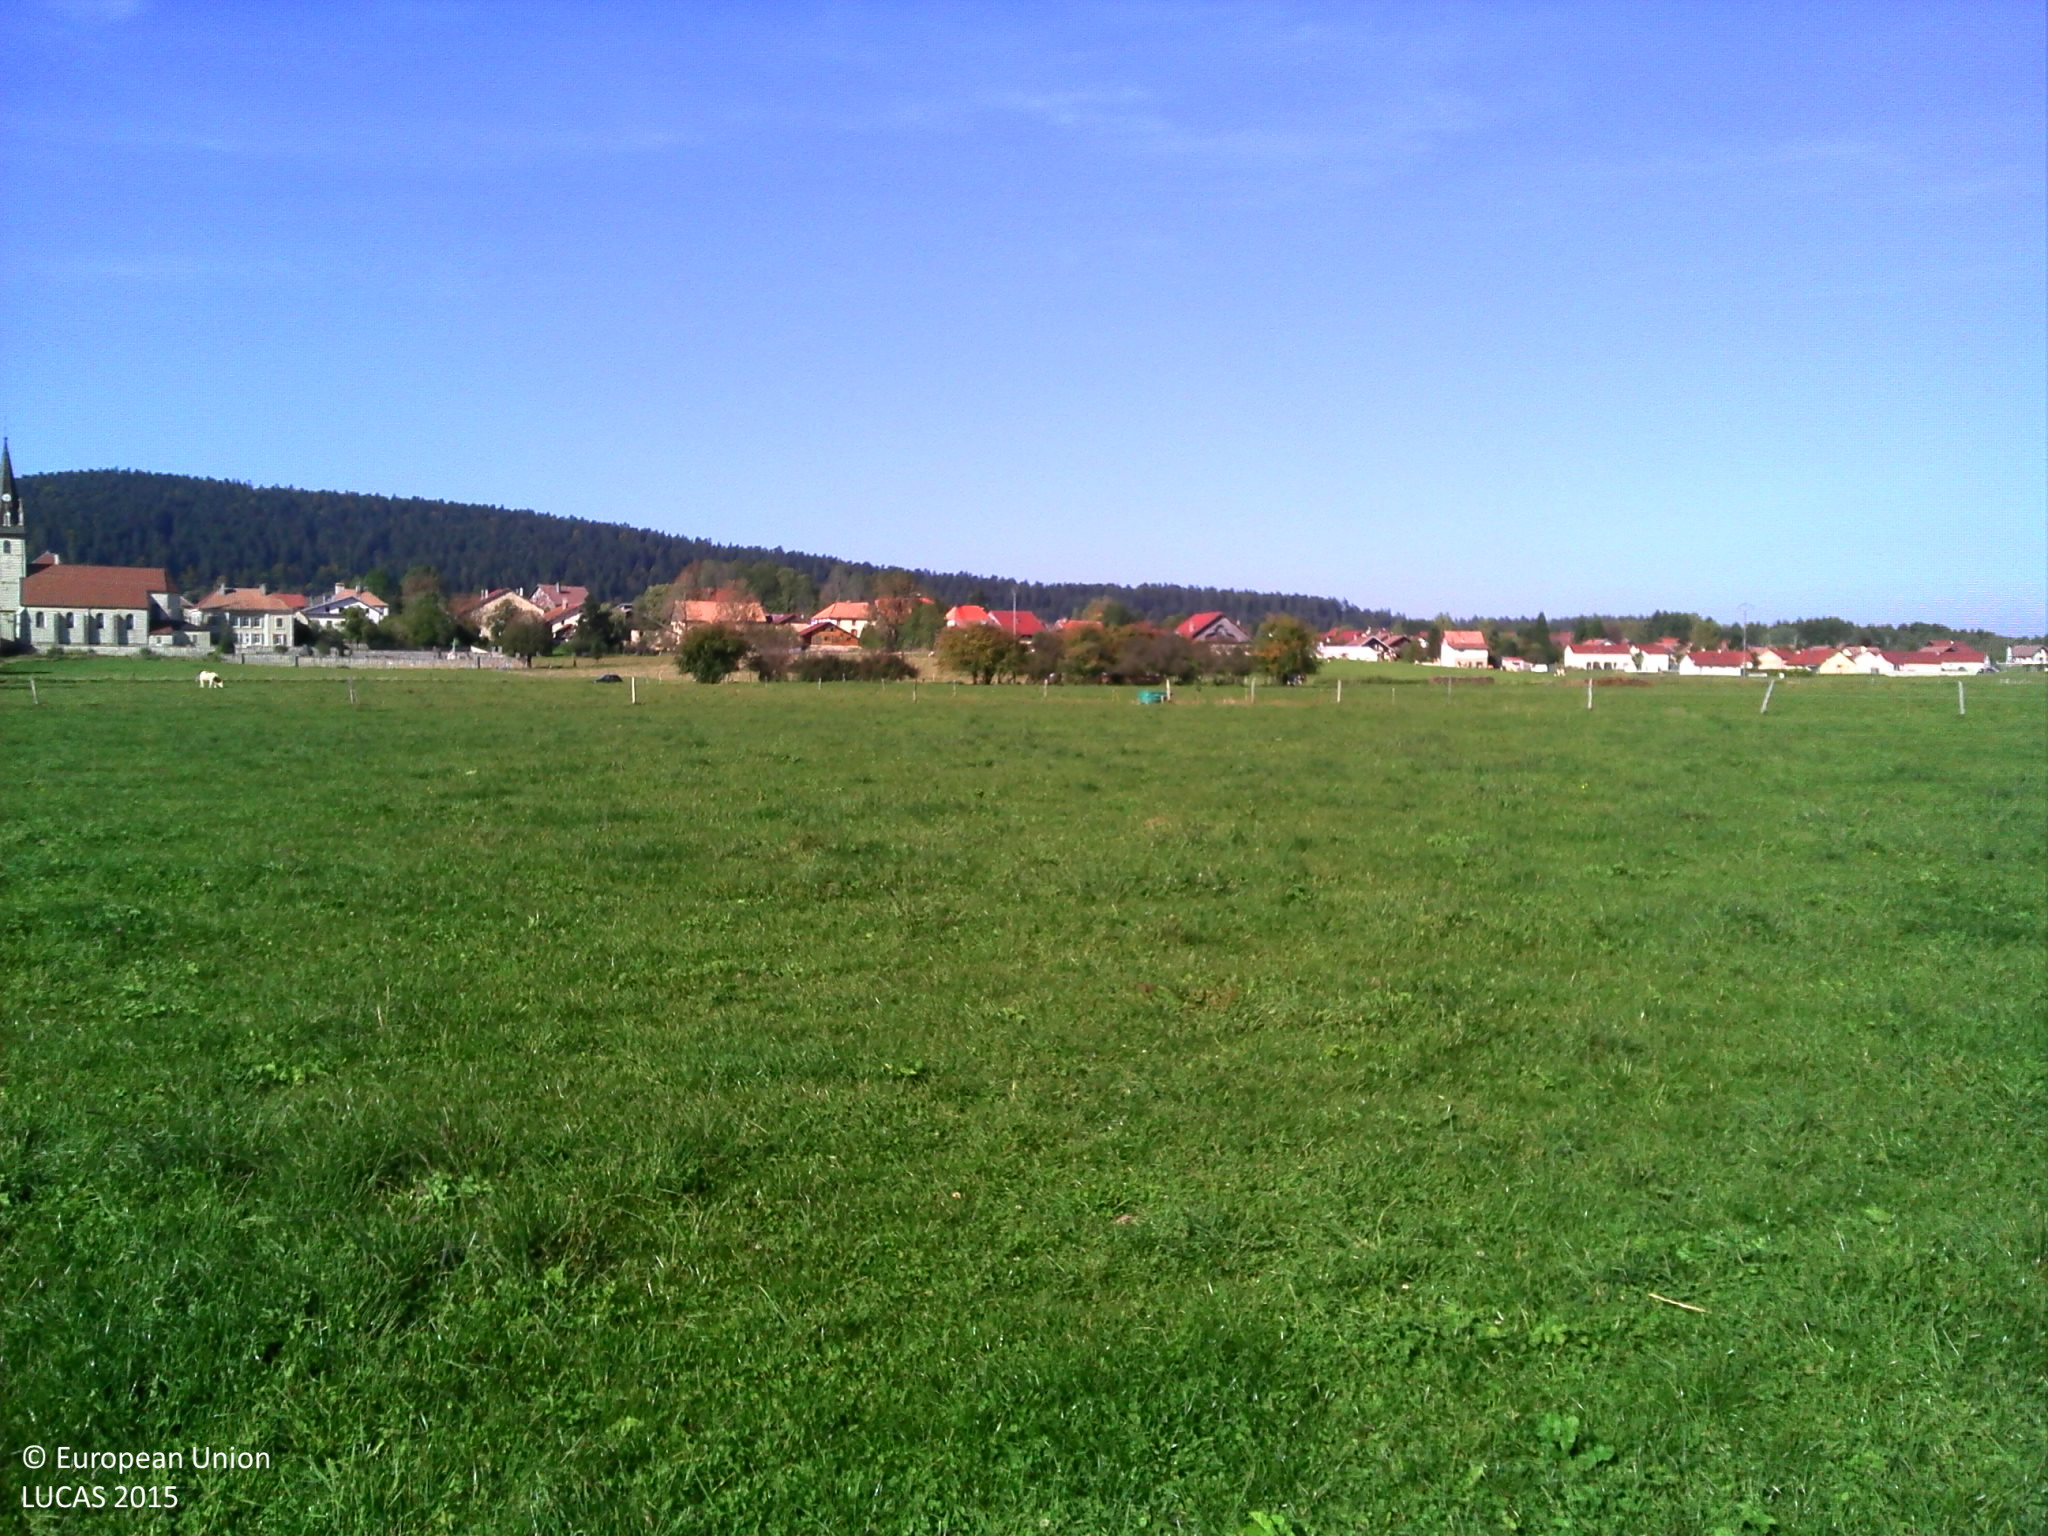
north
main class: Grassland
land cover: Grassland without tree/shrub cover
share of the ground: > 75 %
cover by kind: herbaceous plants 100 %
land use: Agriculture (excluding fallow land and kitchen gardens)
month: October
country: FR
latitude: 47.0471
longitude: 6.3825
